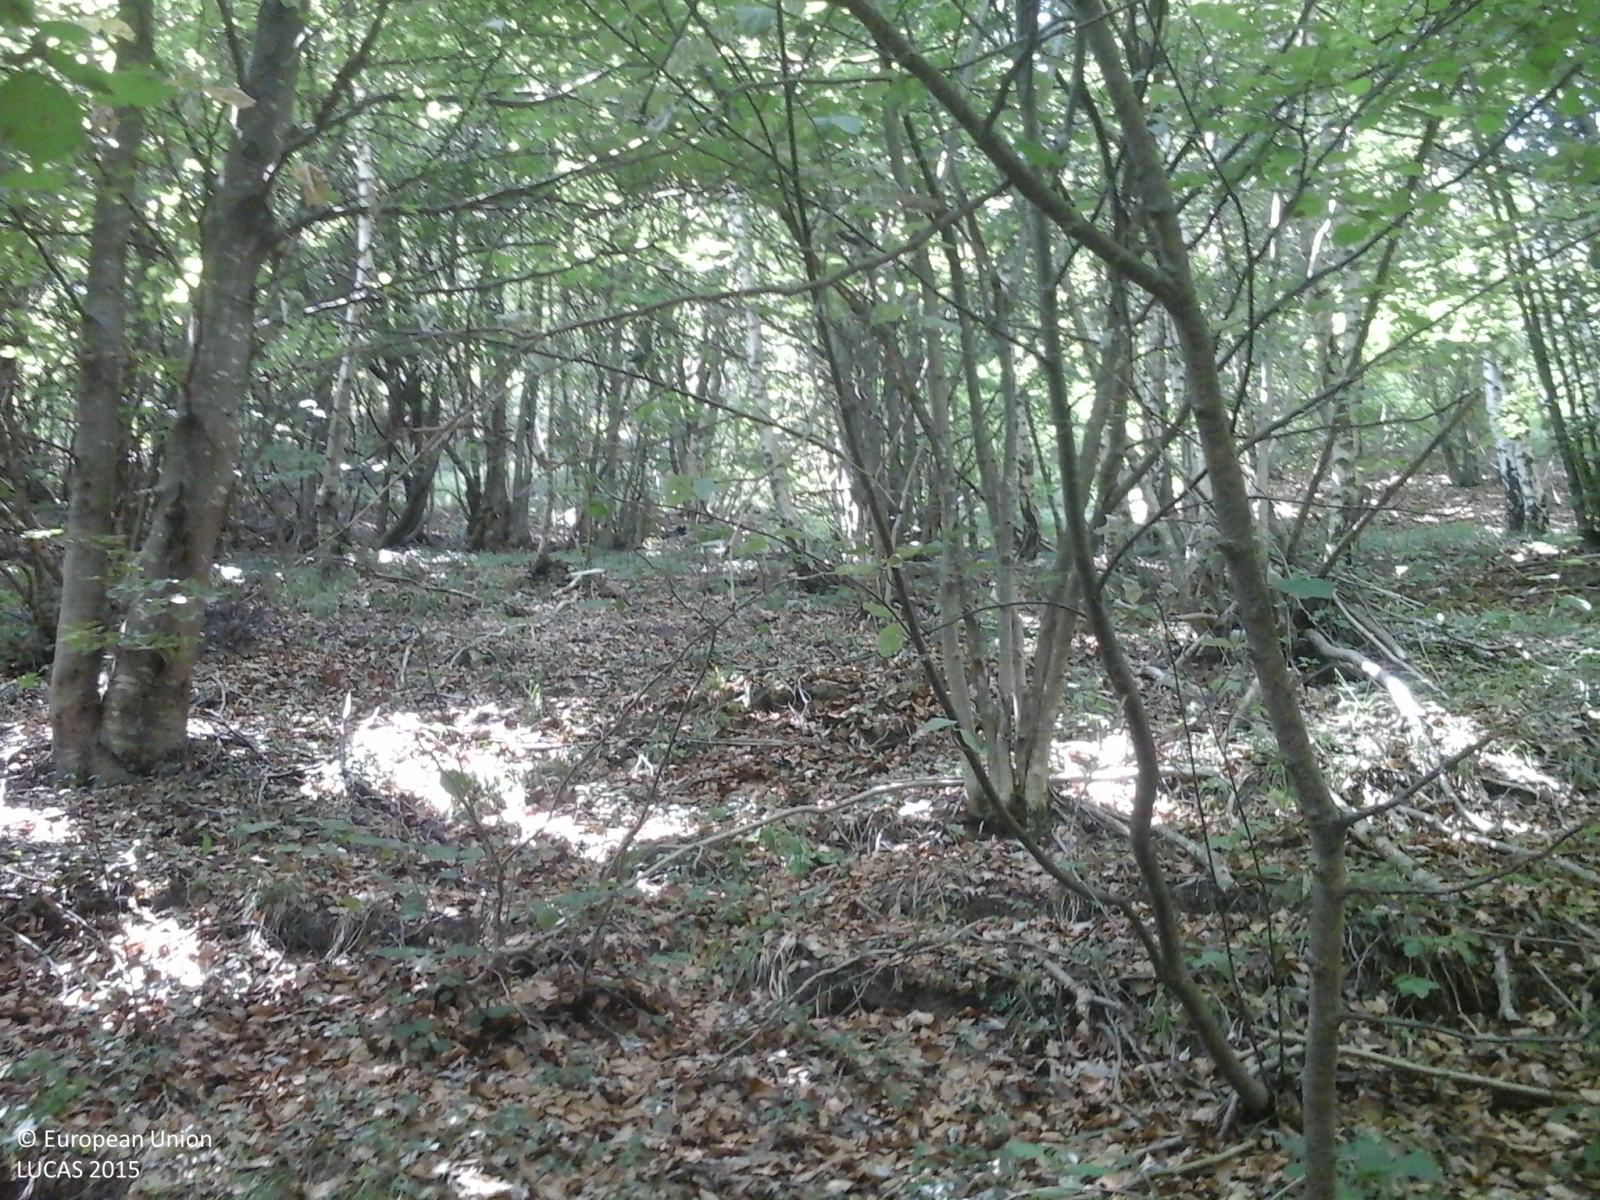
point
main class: Woodland
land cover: Broadleaved woodland
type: mountainous beech forest
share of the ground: > 75 %
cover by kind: broadleaved forest trees 100 %
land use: Forestry
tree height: > 5 m
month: July
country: IT
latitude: 45.8996
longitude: 9.4981
